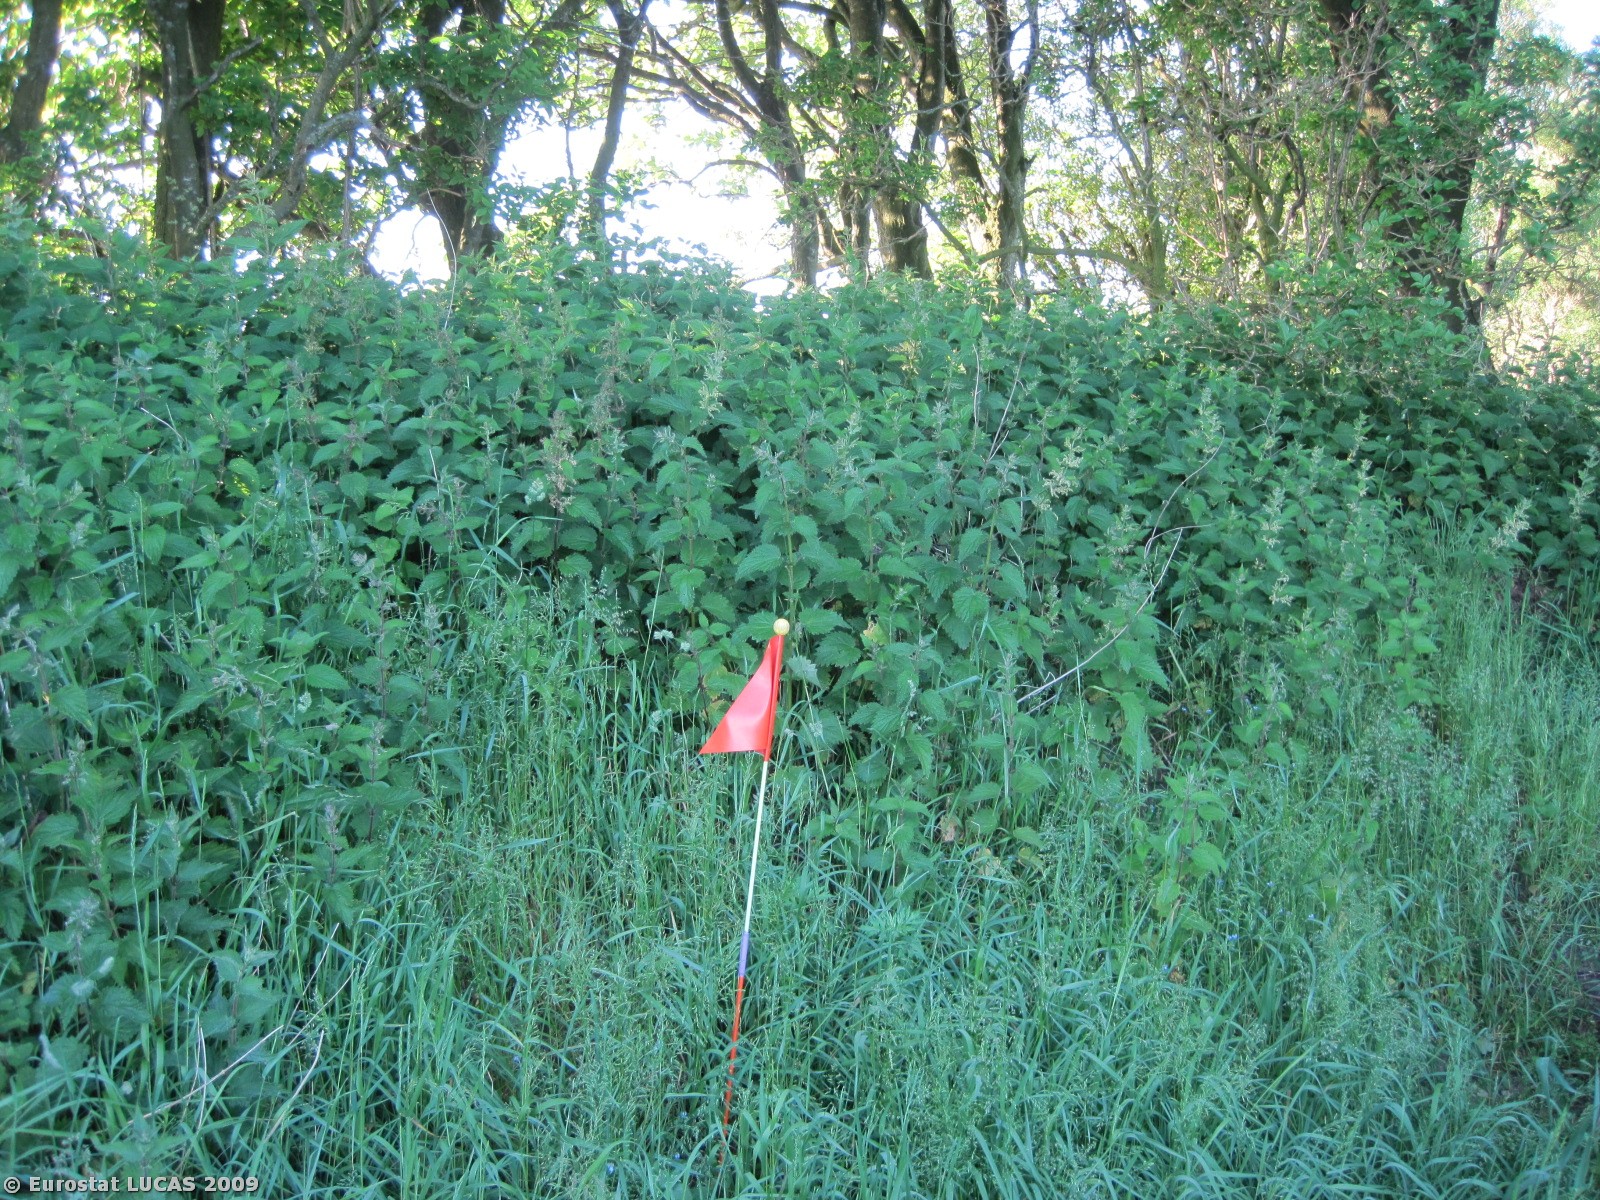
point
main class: Woodland
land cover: Broadleaved woodland
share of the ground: > 75 %
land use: Unused
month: June
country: DK
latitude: 57.1764
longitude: 10.1486
